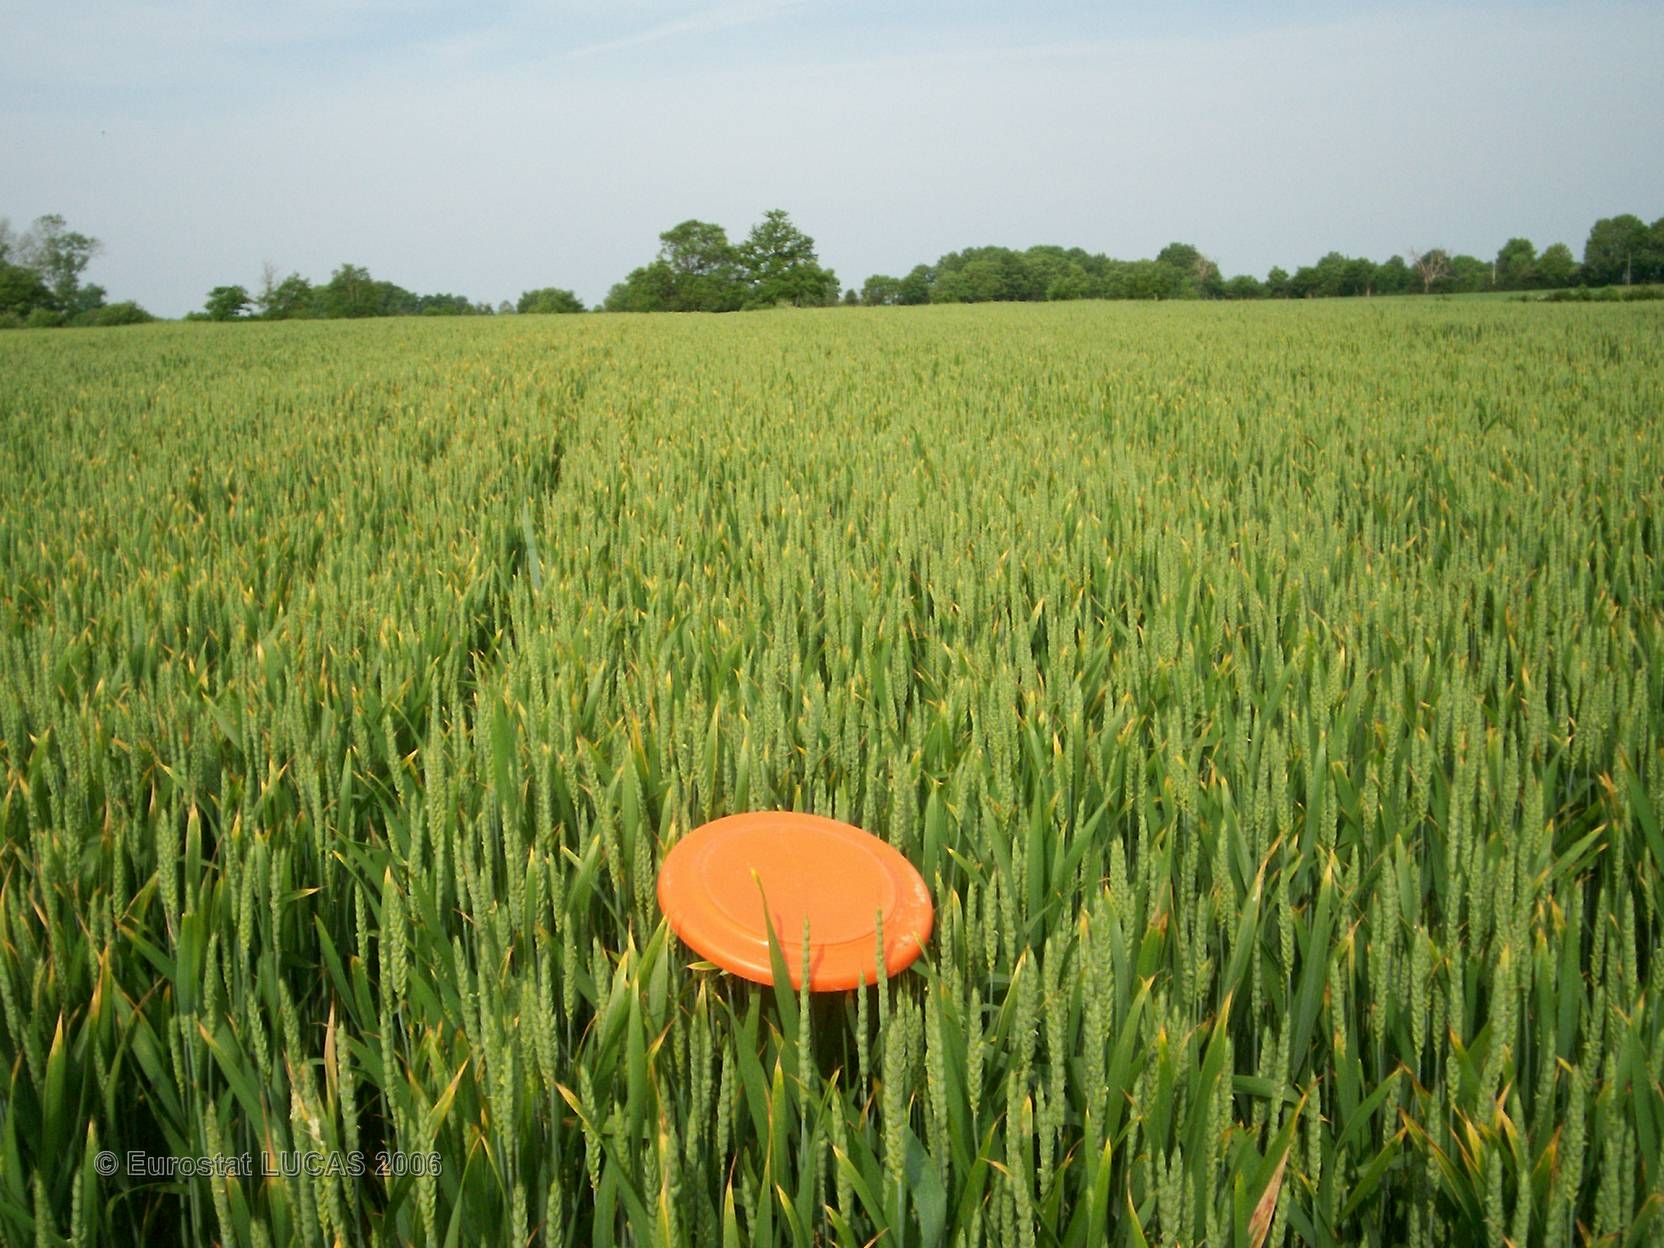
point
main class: Cropland
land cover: Common wheat
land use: Agriculture (excluding fallow land and kitchen gardens)
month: May
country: FR
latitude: 46.6375
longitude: -0.8075
